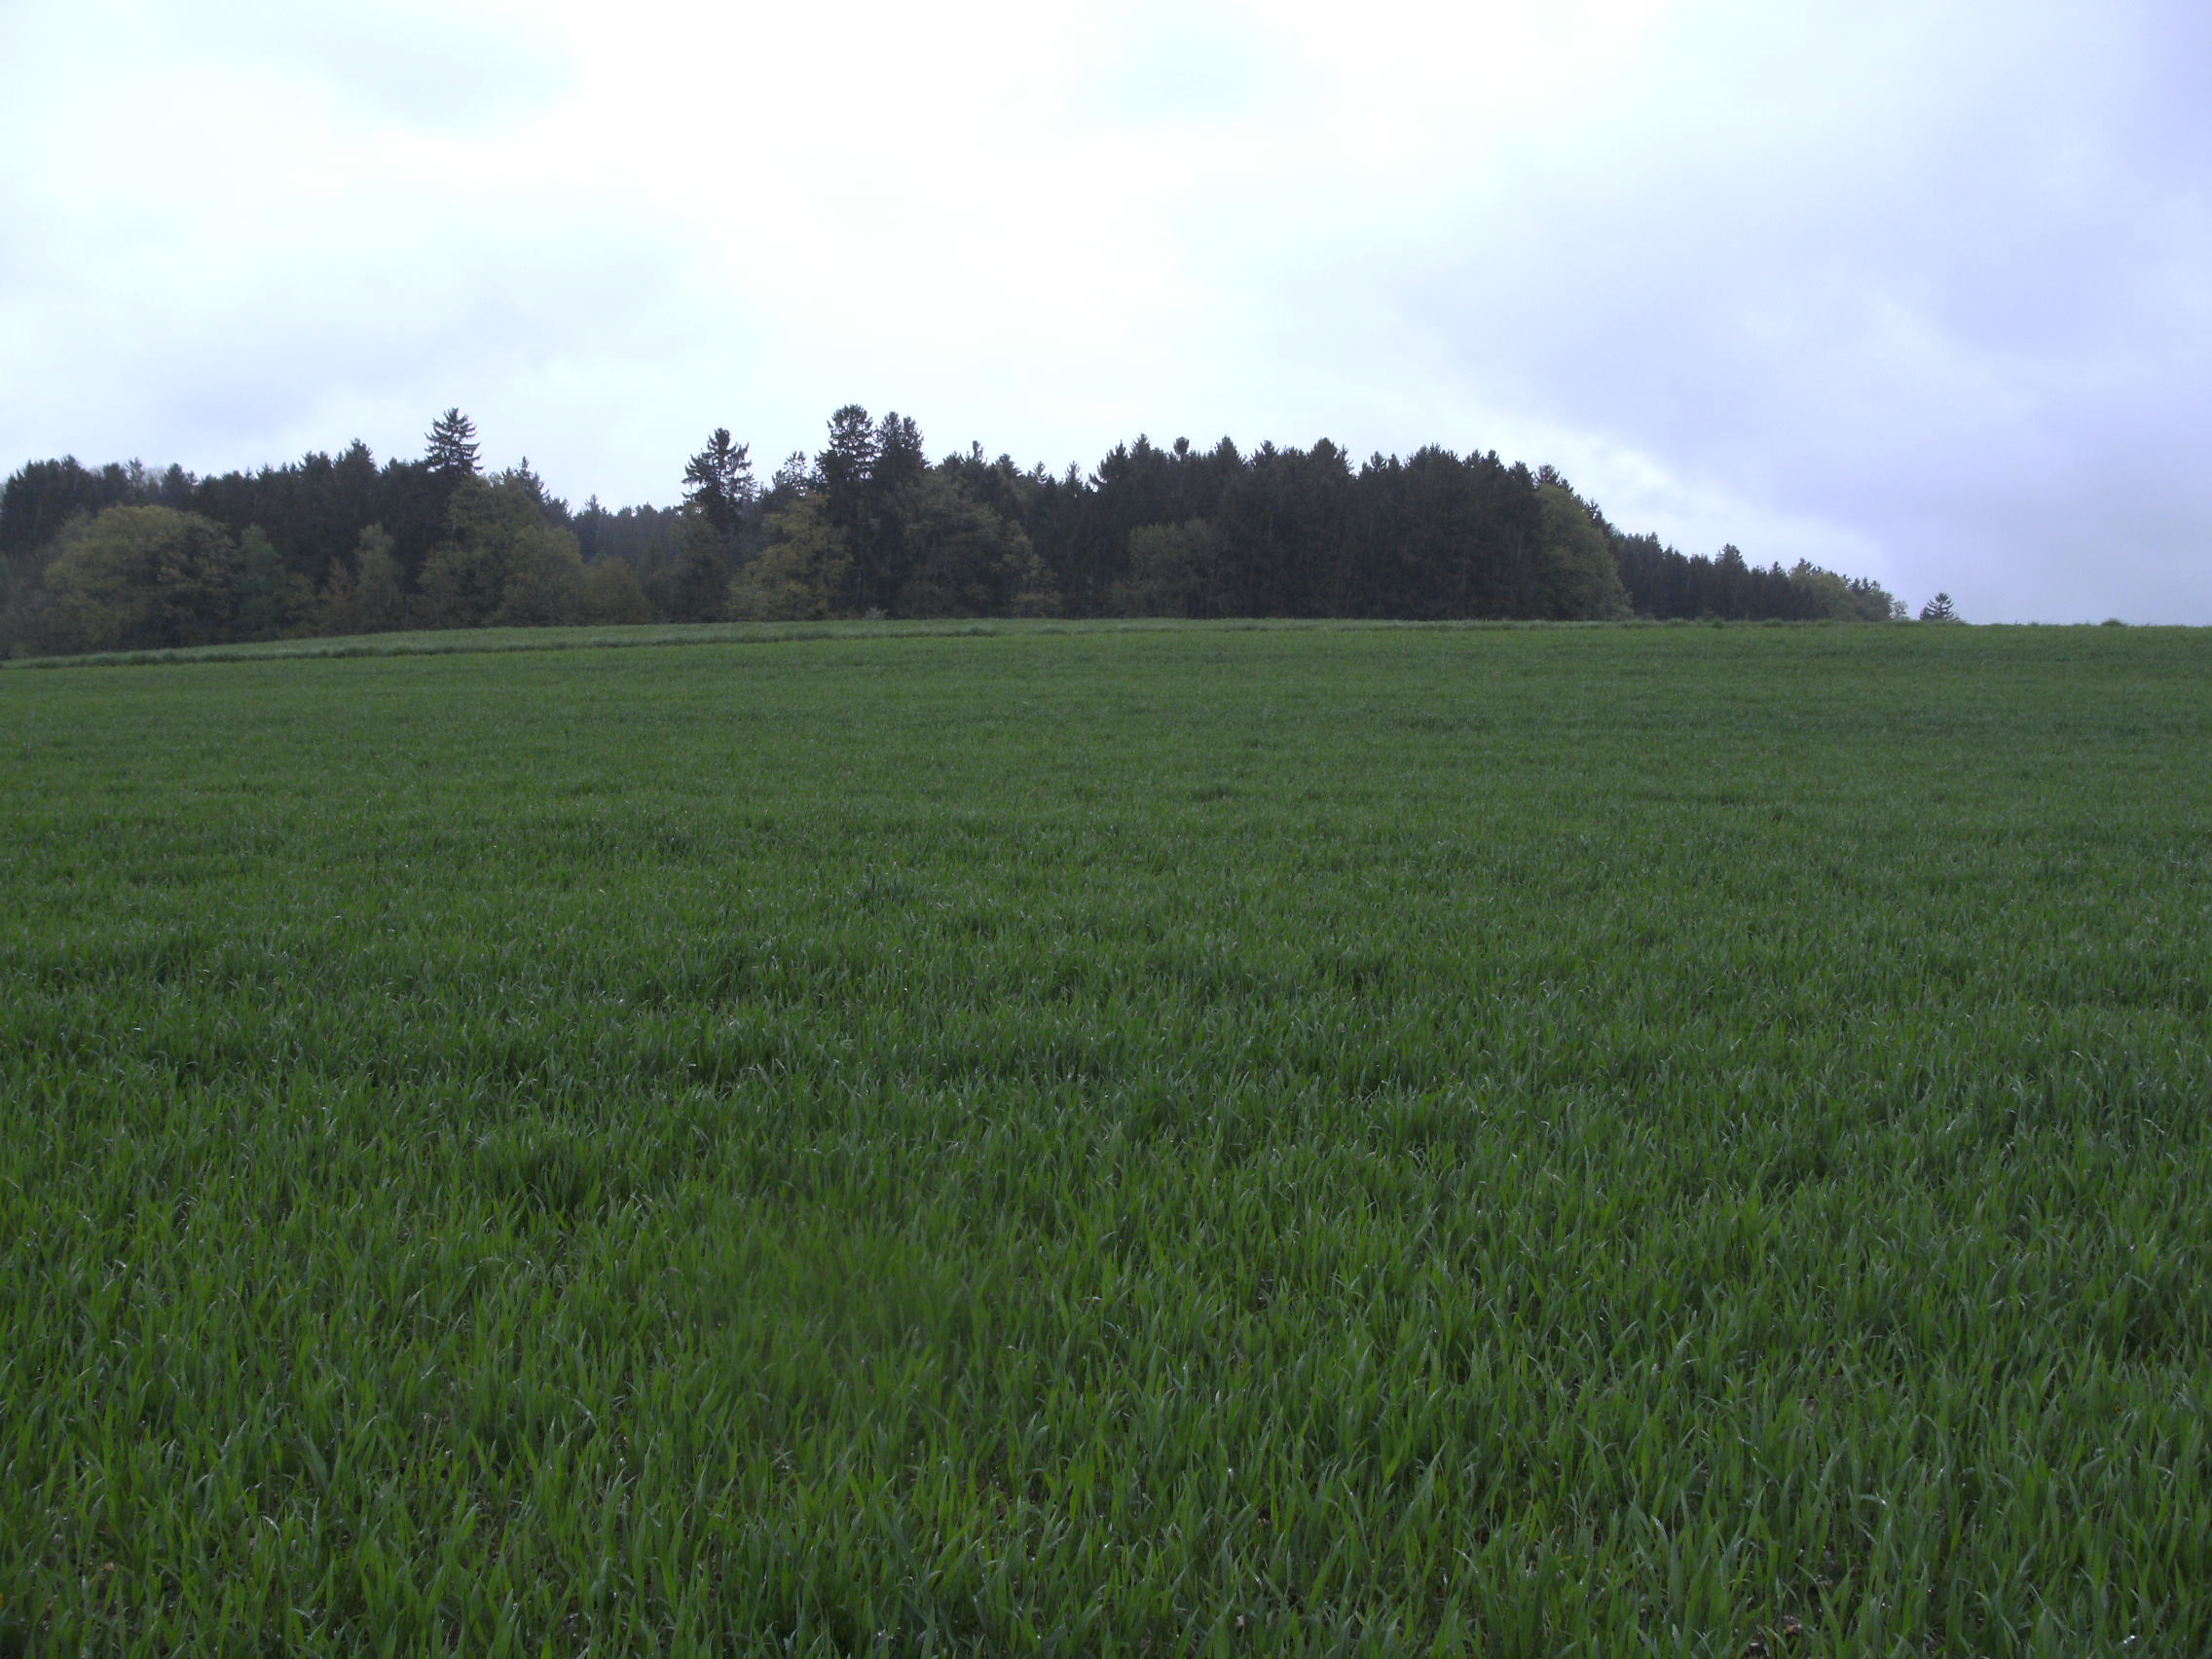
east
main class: Cropland
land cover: Common wheat
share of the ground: > 75 %
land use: Agriculture (excluding fallow land and kitchen gardens)
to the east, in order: Common wheat; Paved roads, cycling and walking lanes; Common wheat
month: May
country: AT
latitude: 48.1840
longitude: 13.5636
